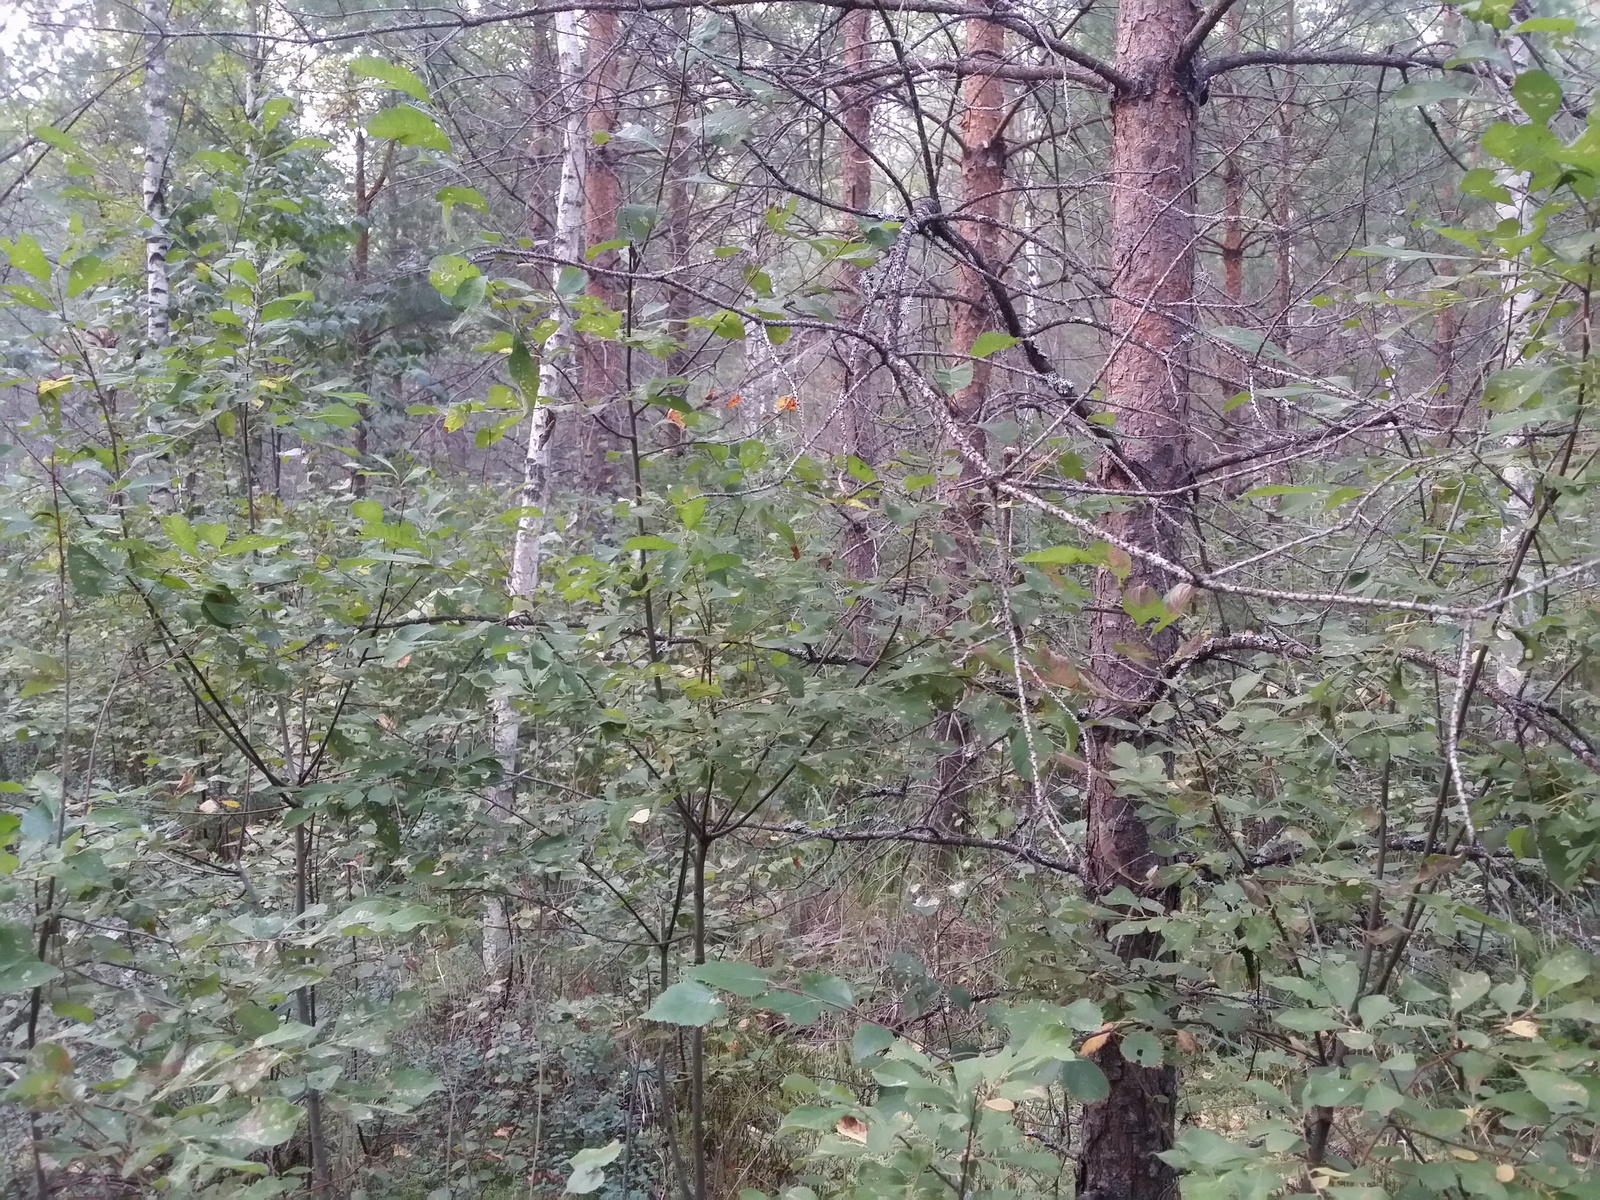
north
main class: Woodland
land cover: Pine dominated mixed woodland
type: hemiboreal forest and nemoral coniferous forest and mixed broadleaved-coniferous forest
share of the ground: > 75 %
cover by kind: coniferous forest trees 35 %, broadleaved forest trees 30 %, herbaceous plants 20 %, shrubs 10 %, lichens and mosses 5 %
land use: Forestry
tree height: > 5 m
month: August
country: LV
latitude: 56.9822
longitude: 27.2317
